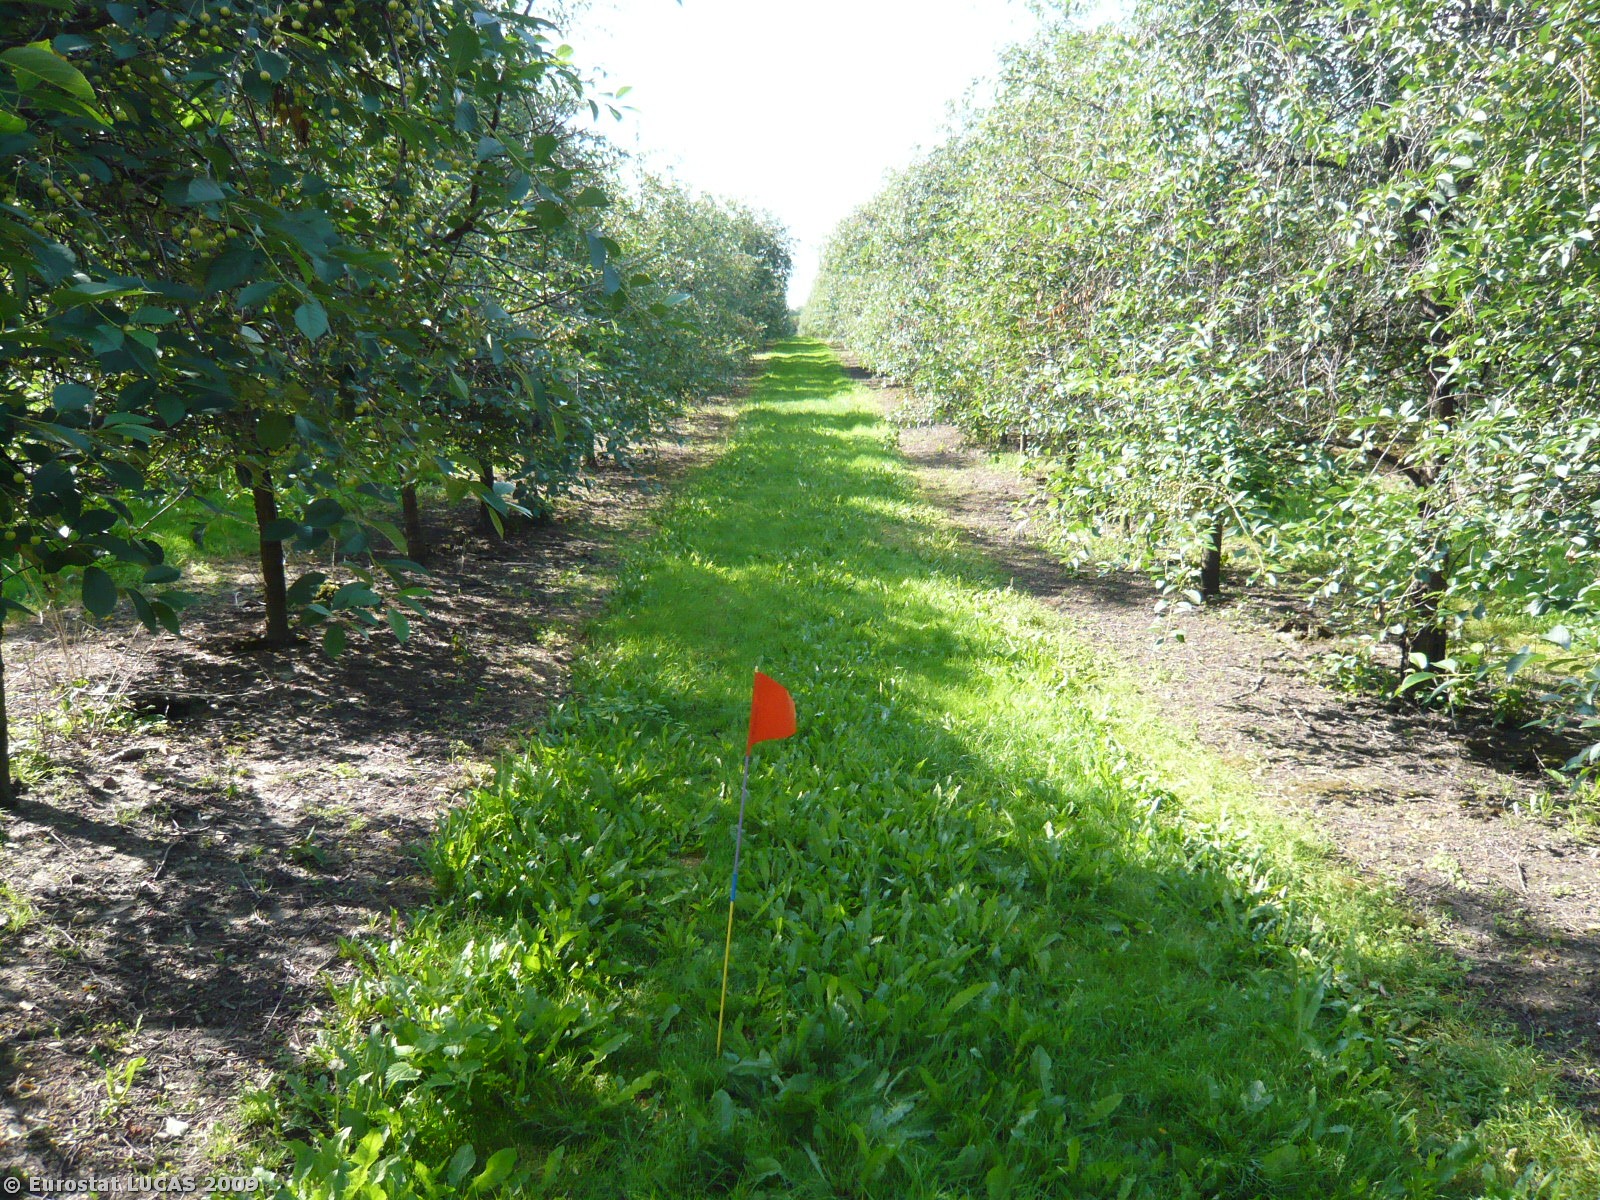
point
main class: Cropland
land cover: Cherry fruit
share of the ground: 50 - 75 %
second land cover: Grassland with sparse tree/shrub cover
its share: 25 - 50 %
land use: Agriculture (excluding fallow land and kitchen gardens)
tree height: < 5 m
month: July
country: DK
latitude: 55.3586
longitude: 10.7722
